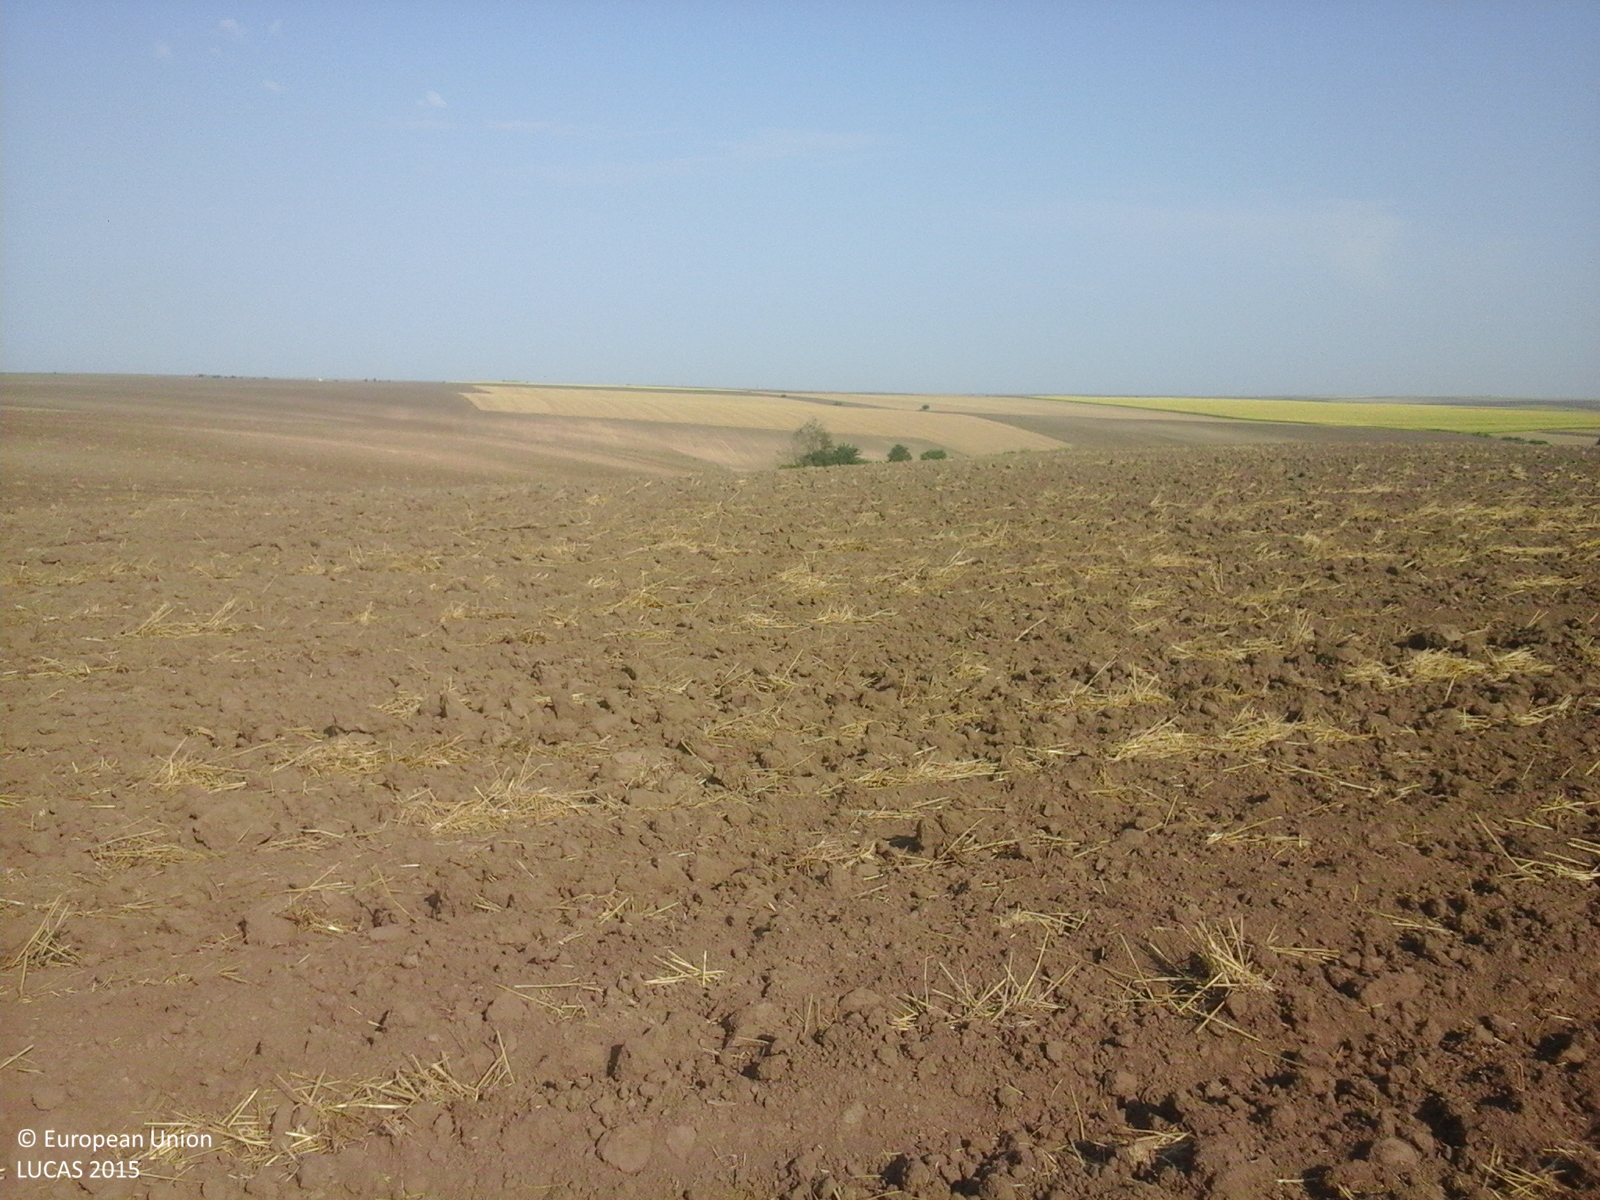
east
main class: Cropland
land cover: Common wheat
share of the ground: < 10 %
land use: Agriculture (excluding fallow land and kitchen gardens)
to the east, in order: Common wheat
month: August
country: RO
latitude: 44.0318
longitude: 28.0079
